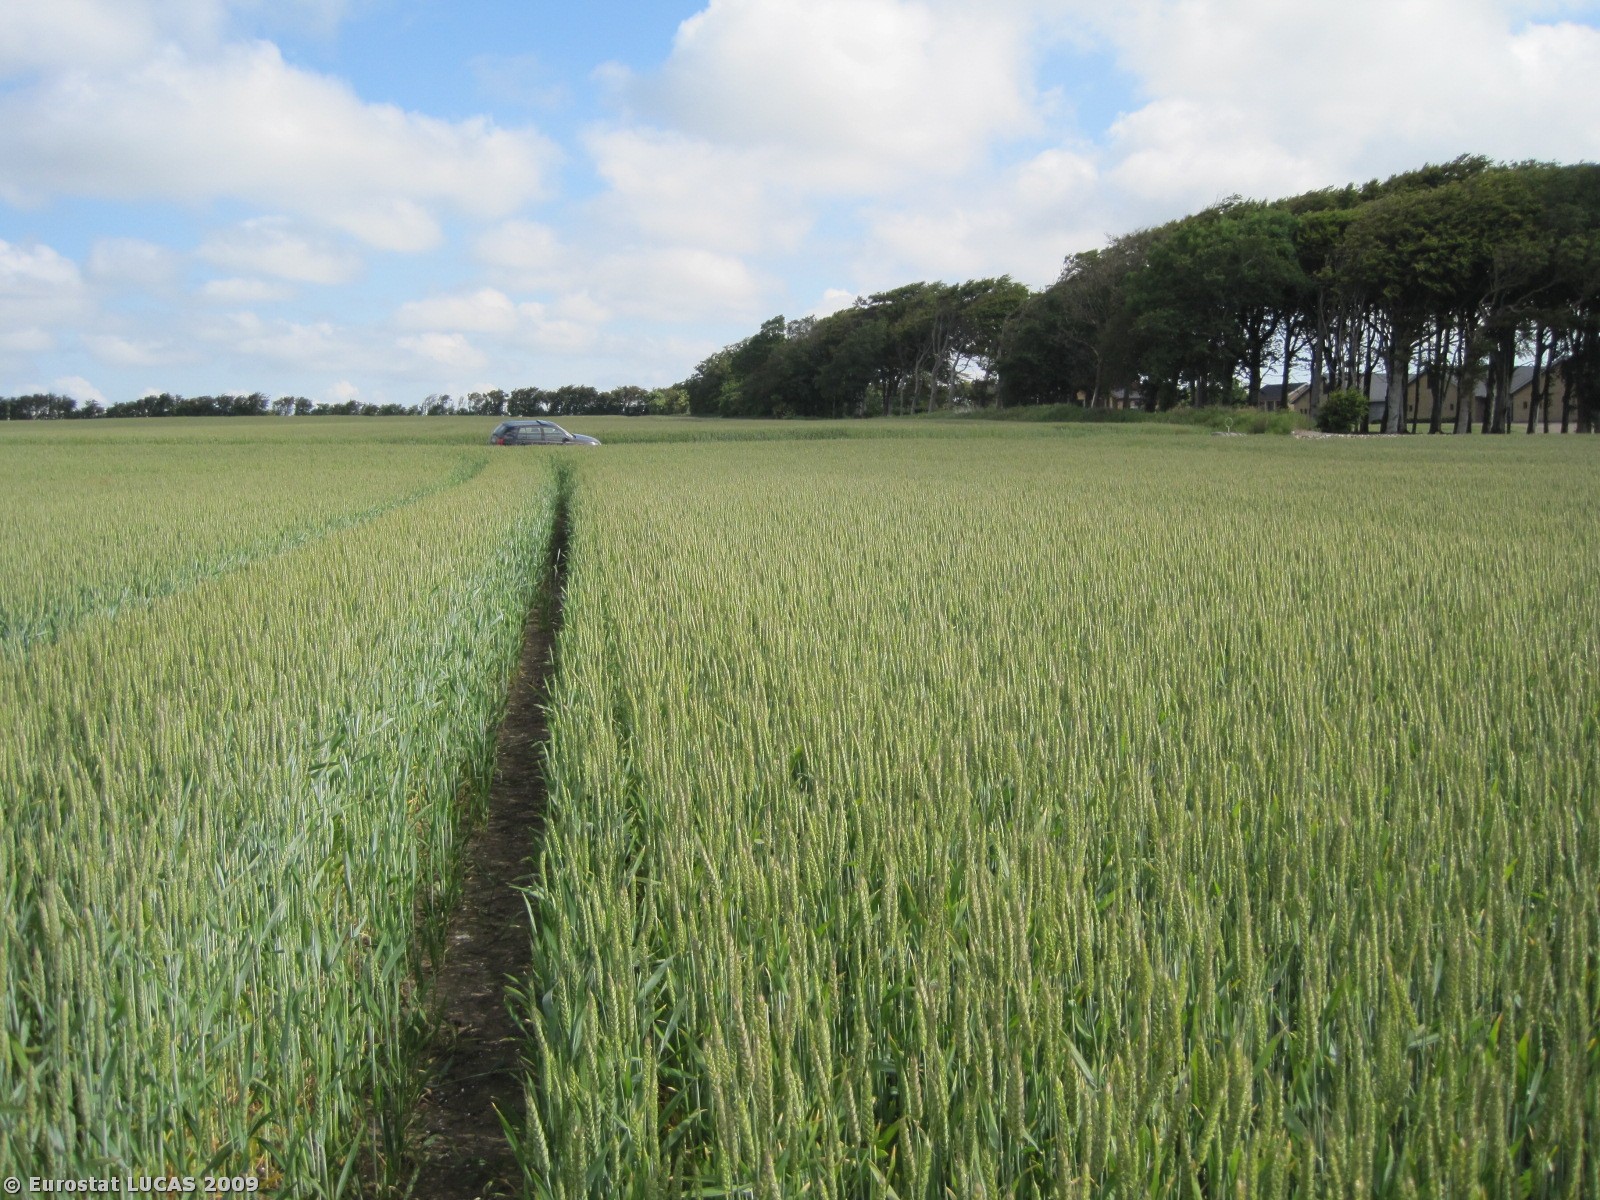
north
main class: Cropland
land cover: Common wheat
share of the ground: > 75 %
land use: Agriculture (excluding fallow land and kitchen gardens)
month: June
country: DK
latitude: 56.7749
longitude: 8.7417
